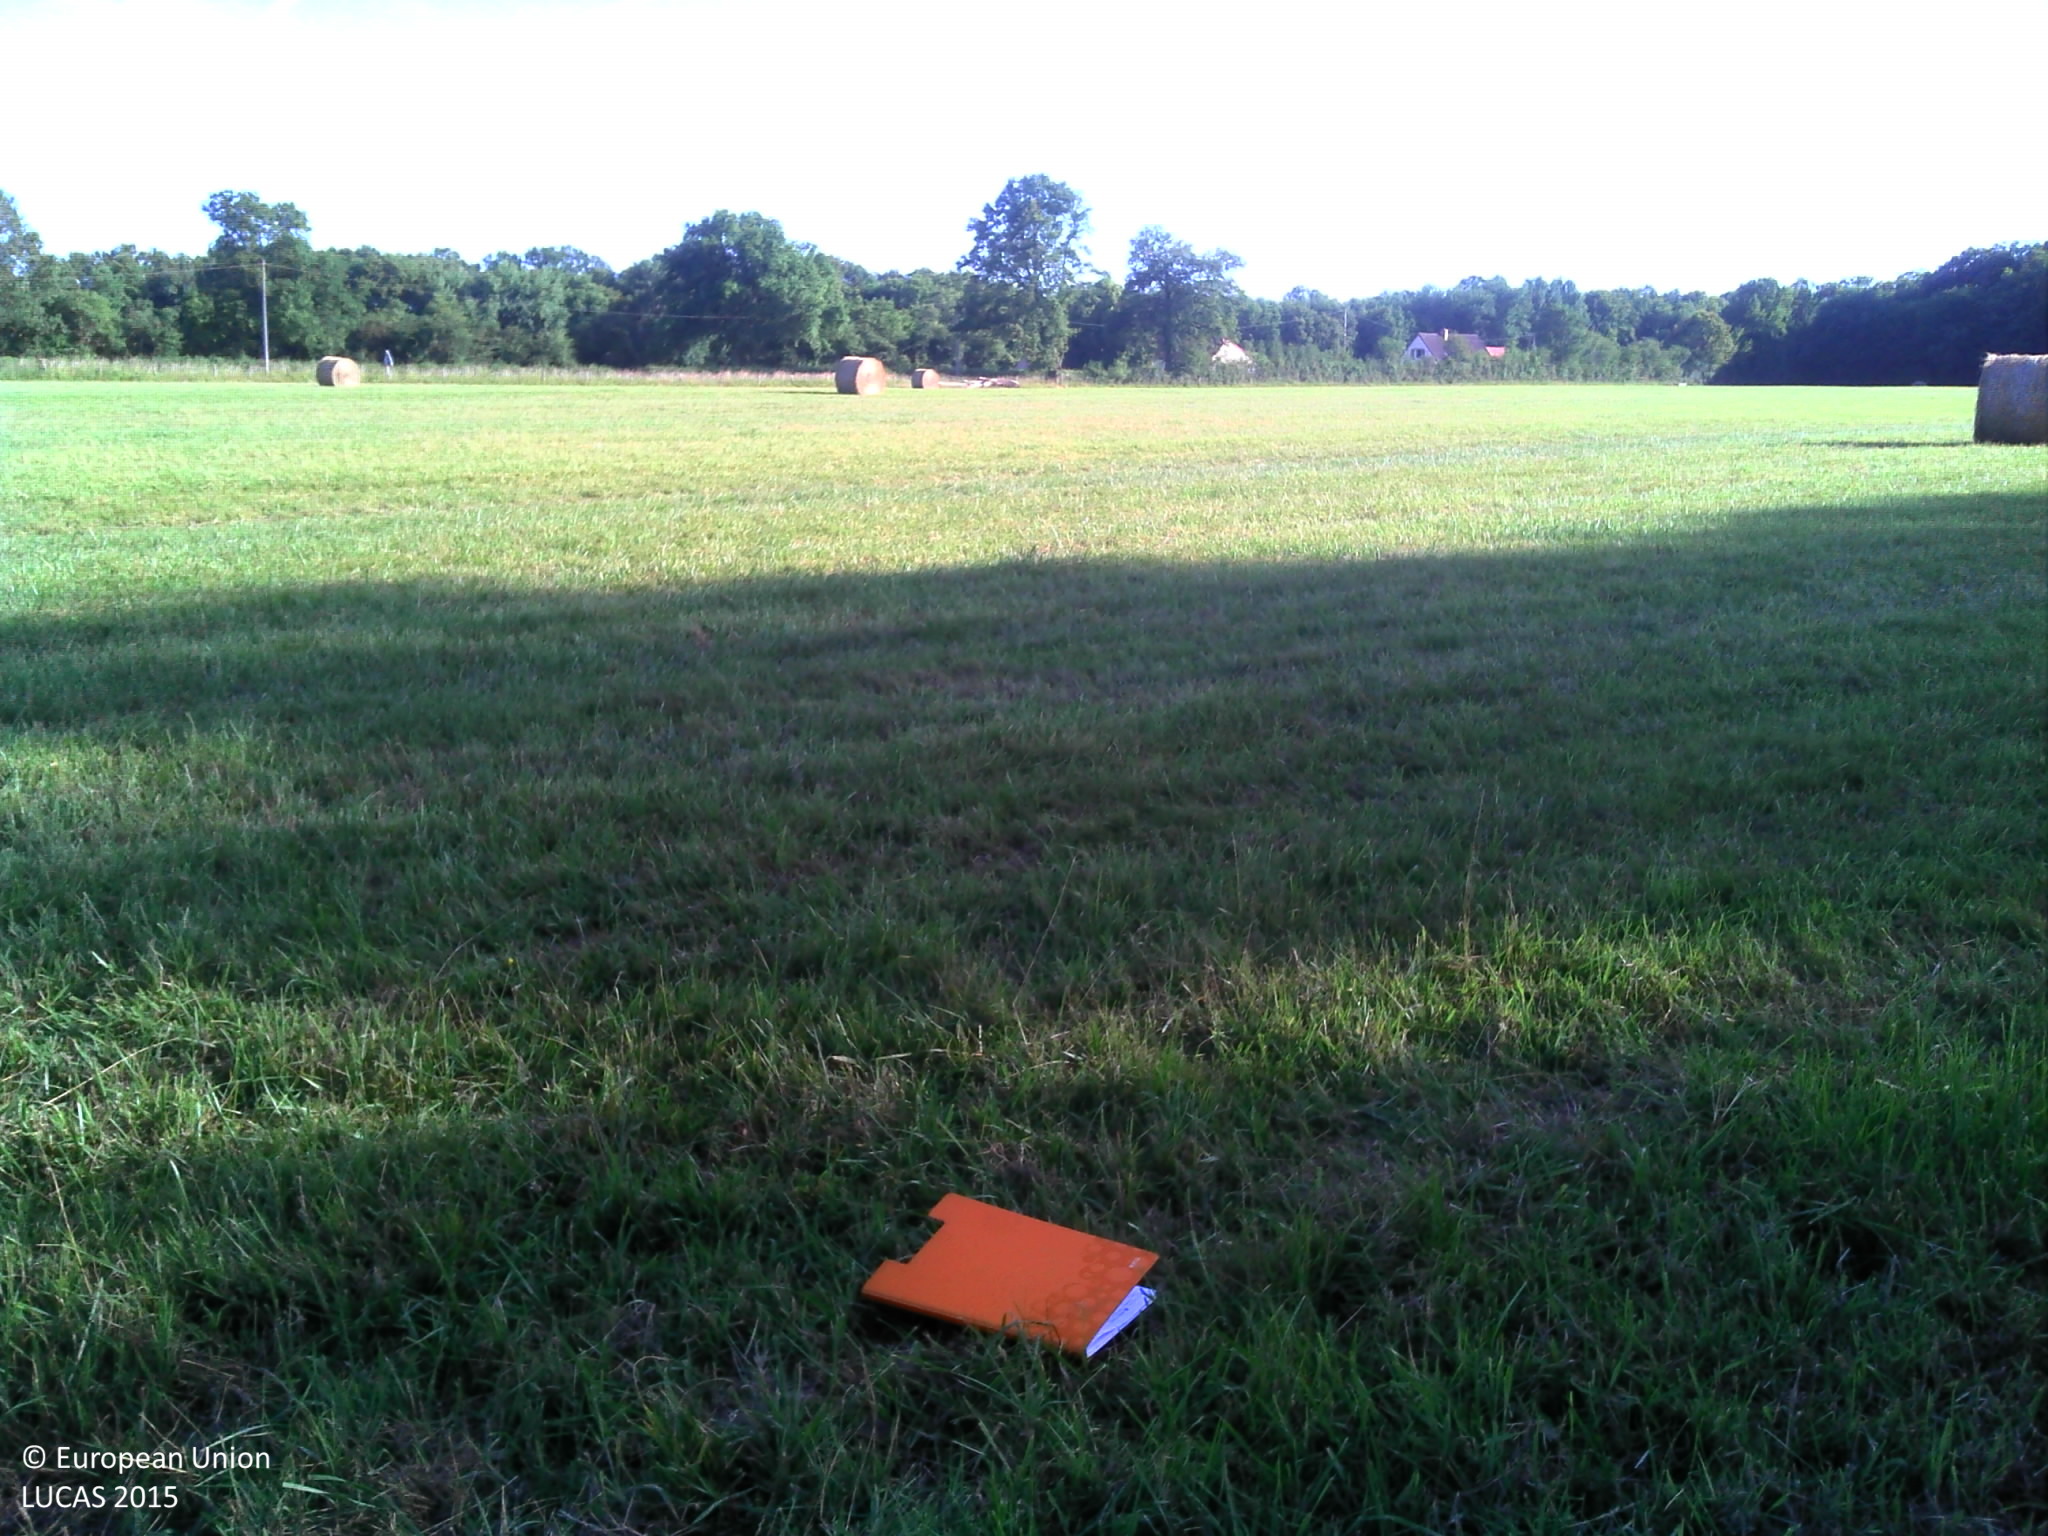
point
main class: Grassland
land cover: Grassland without tree/shrub cover
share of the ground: > 75 %
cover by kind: herbaceous plants 100 %
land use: Agriculture (excluding fallow land and kitchen gardens)
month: June
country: FR
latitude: 46.8434
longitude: 2.9806
